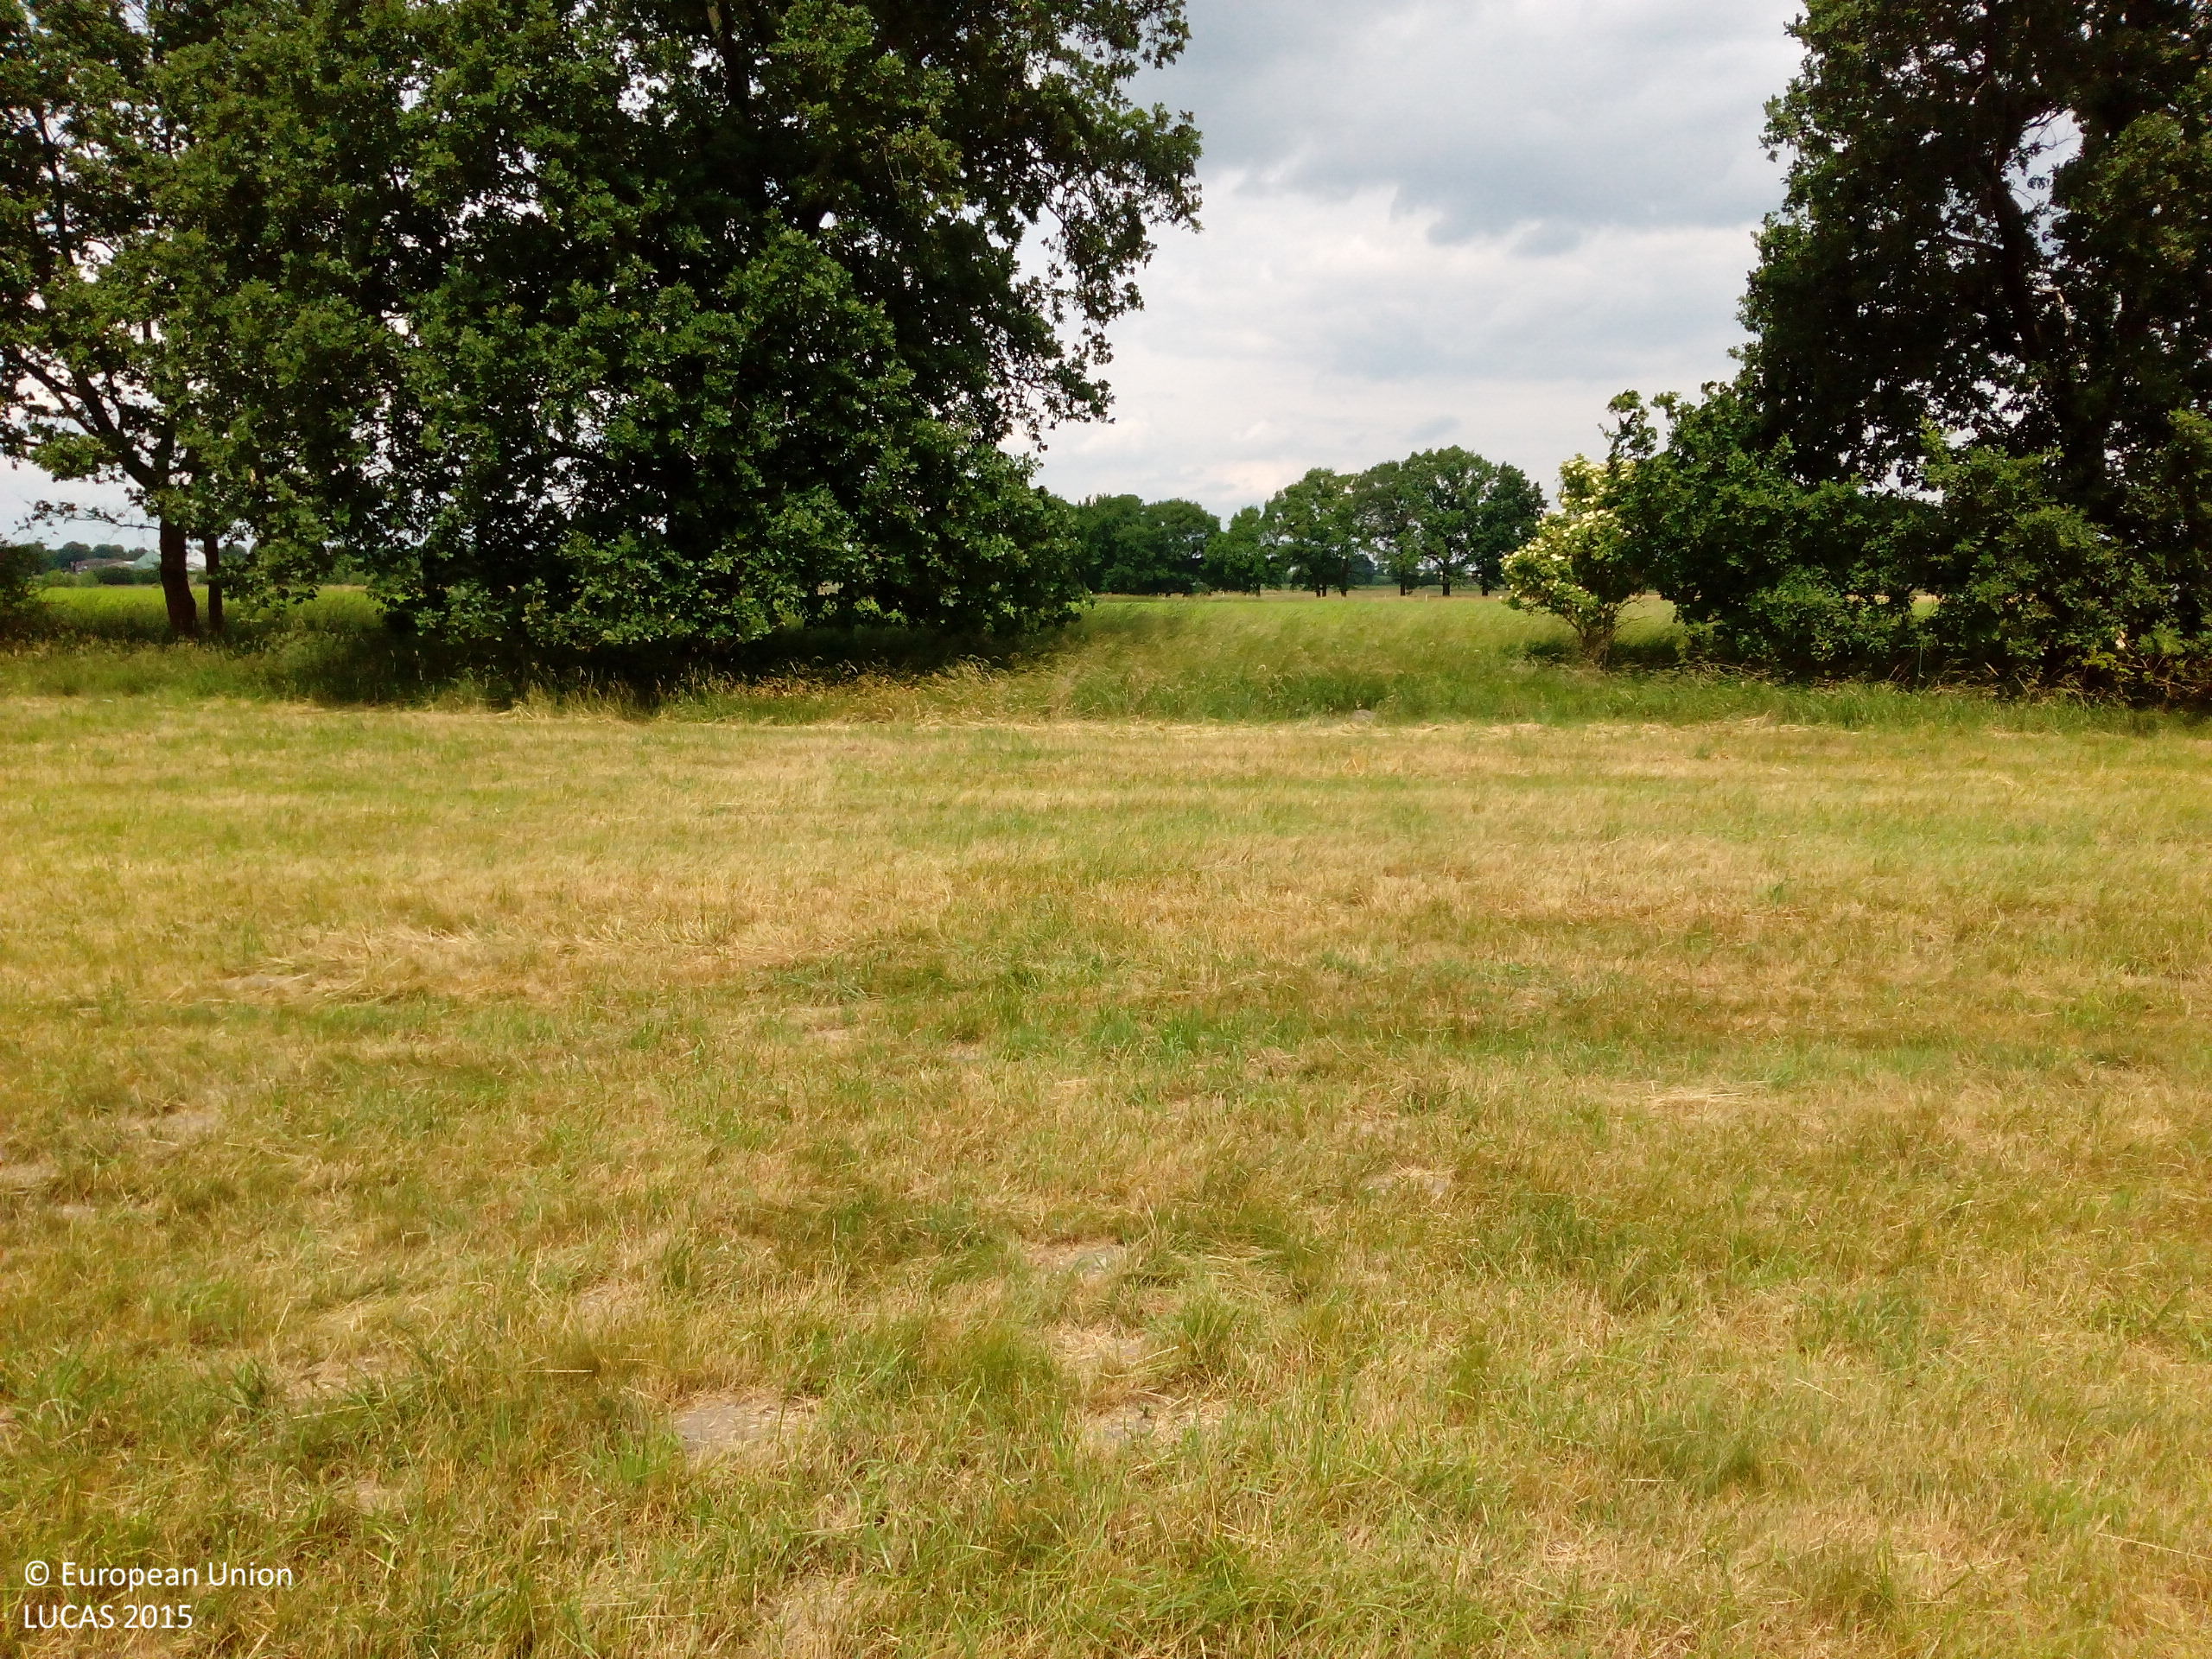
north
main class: Grassland
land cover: Grassland without tree/shrub cover
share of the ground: > 75 %
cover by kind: herbaceous plants 100 %
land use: Agriculture (excluding fallow land and kitchen gardens)
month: June
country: DE
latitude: 52.3771
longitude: 10.2790
